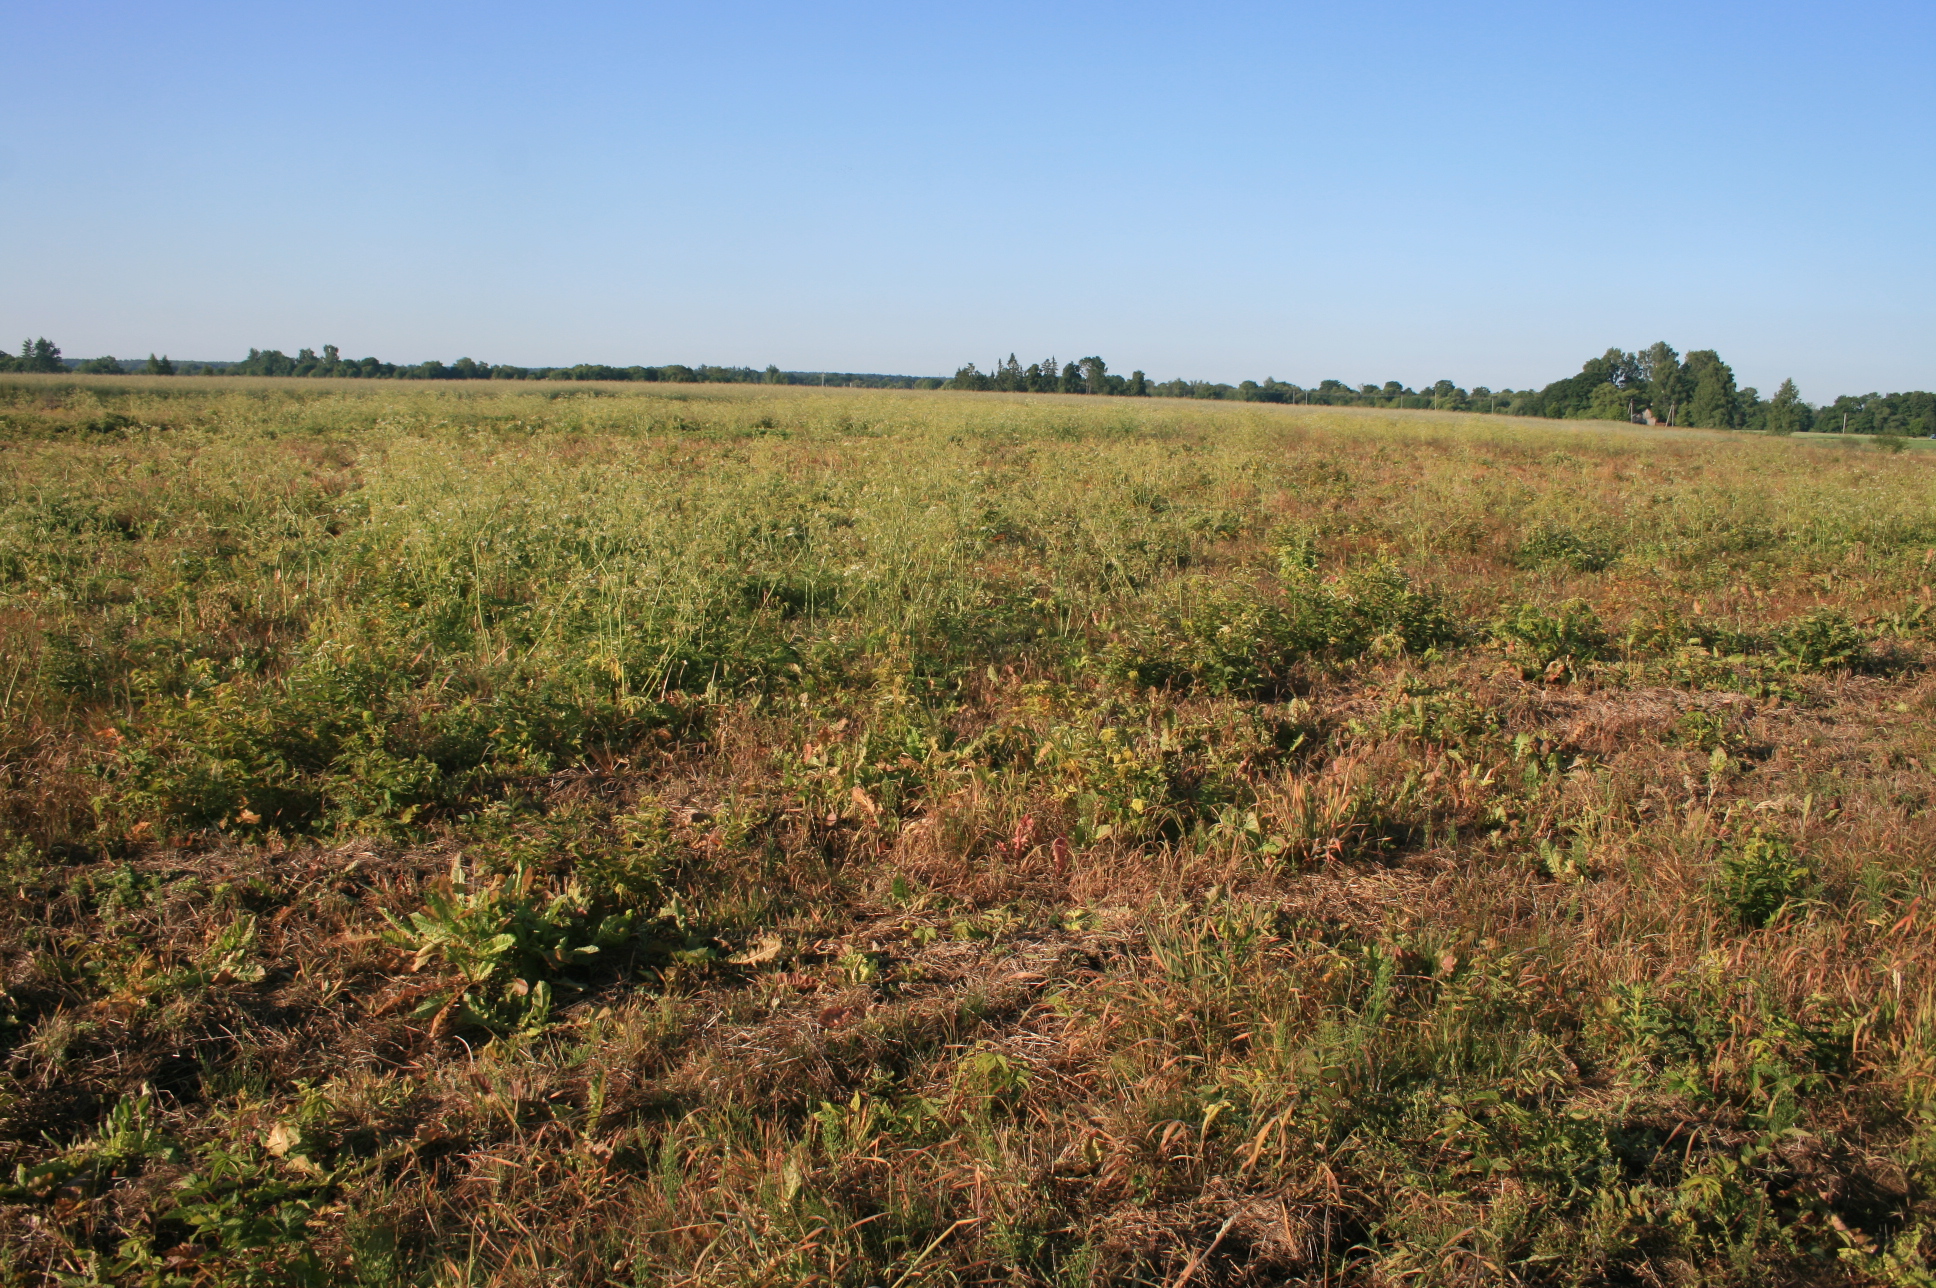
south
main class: Grassland
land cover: Spontaneously vegetated surfaces
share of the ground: > 75 %
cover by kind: herbaceous plants 100 %
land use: Fallow land
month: June
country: LT
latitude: 55.2315
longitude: 22.2755
